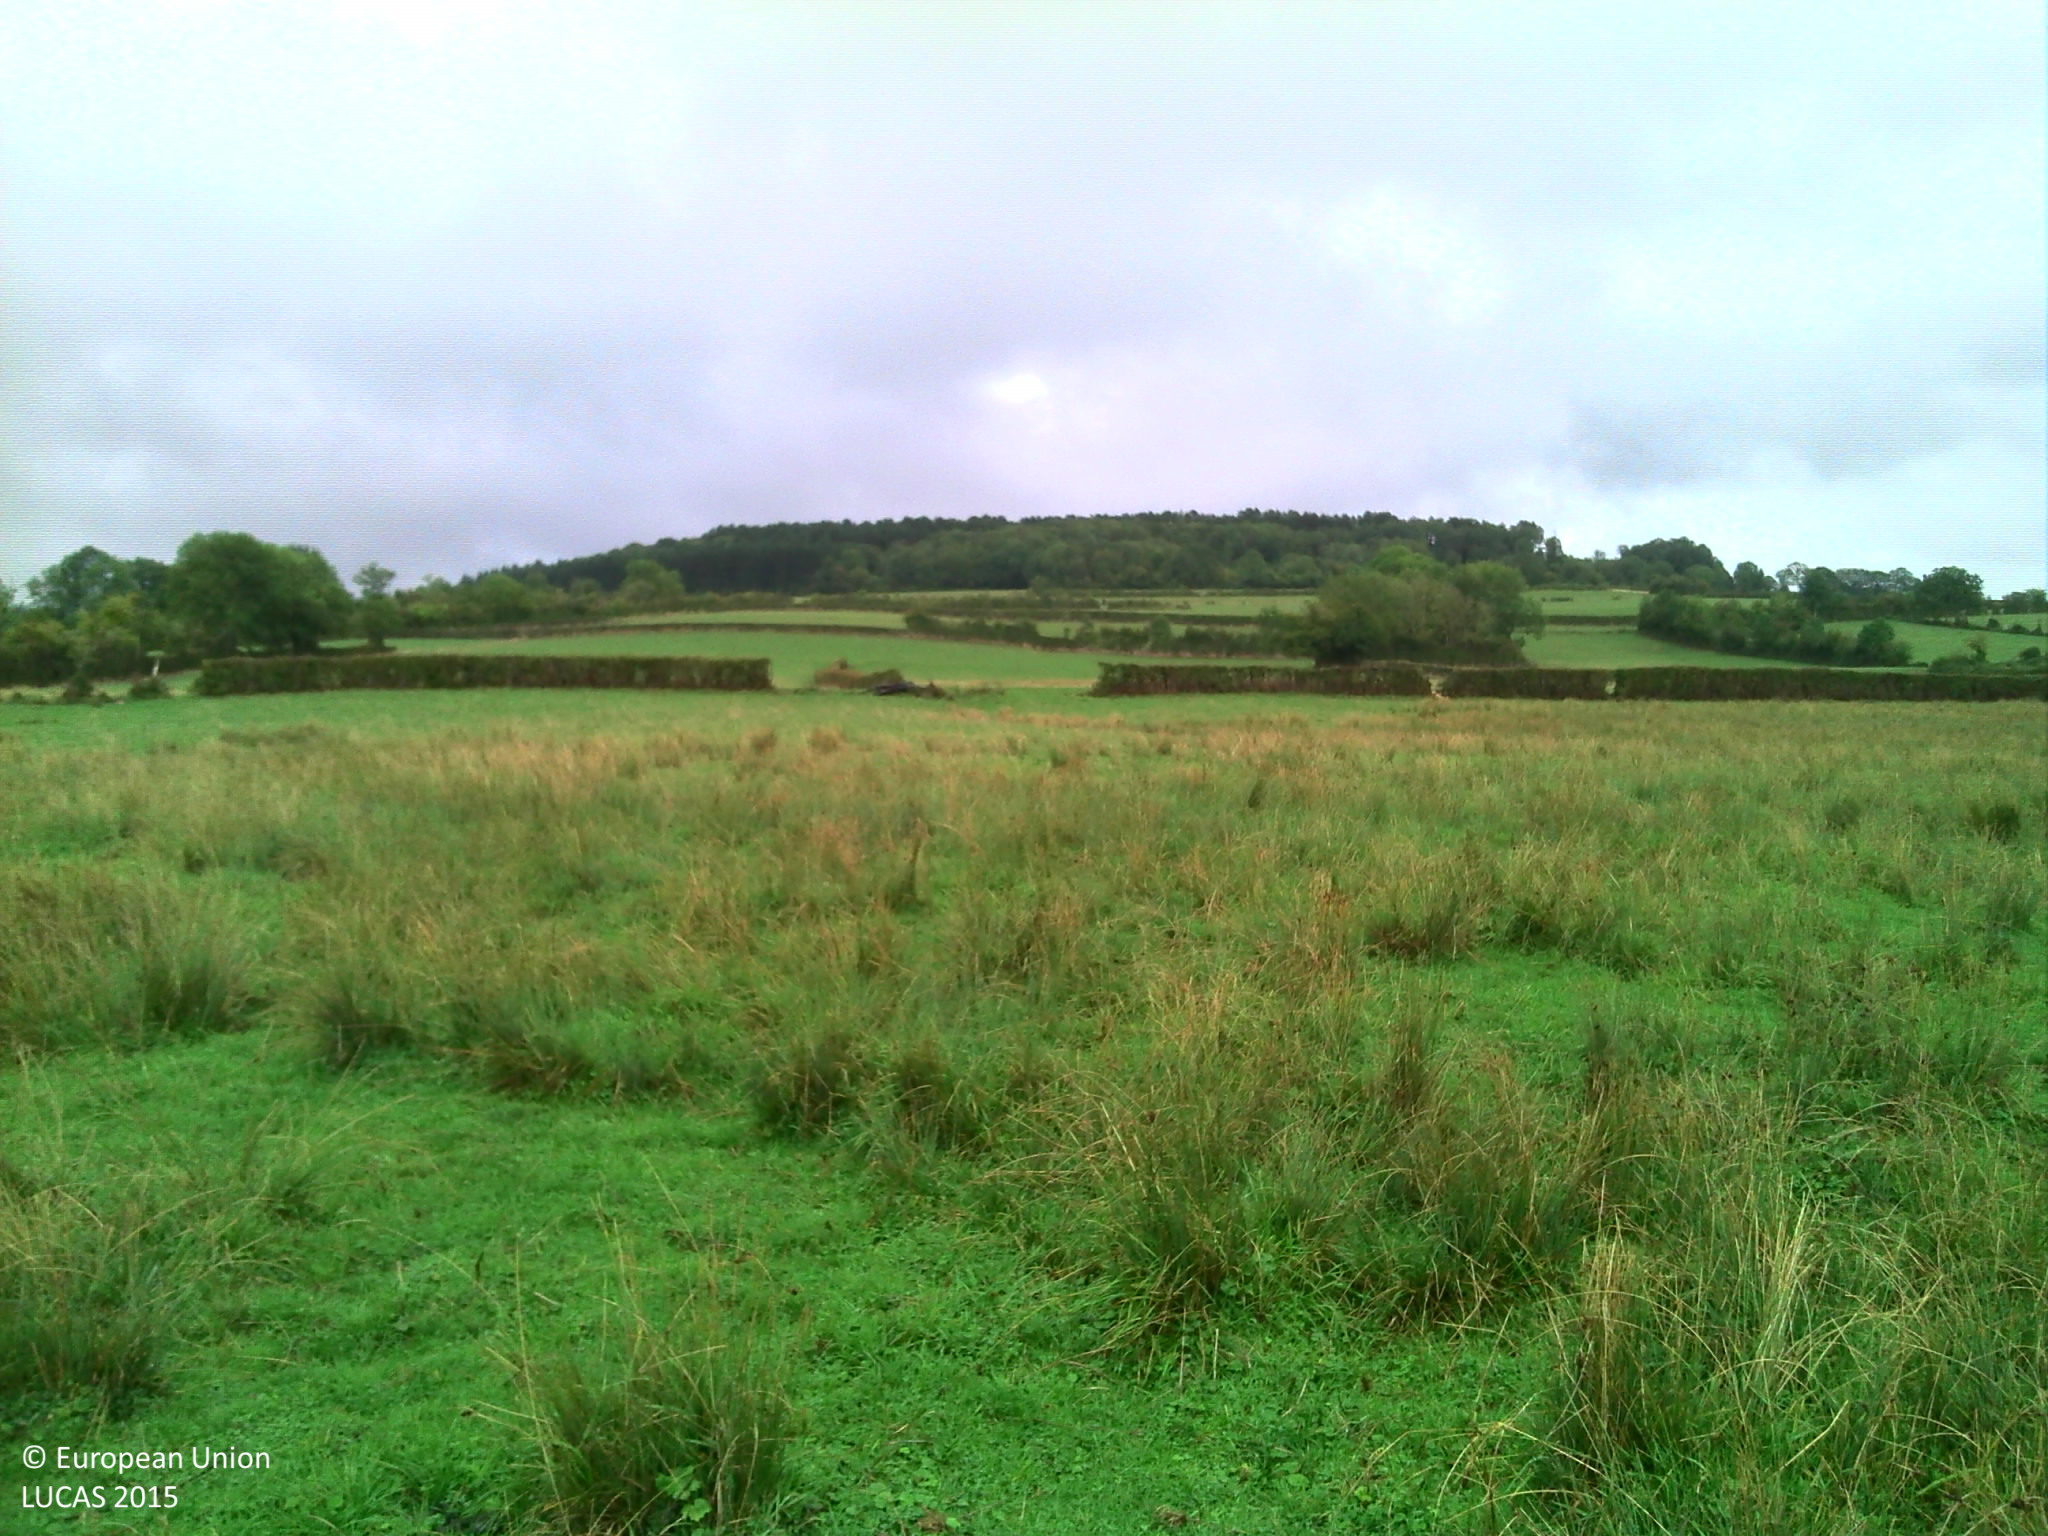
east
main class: Grassland
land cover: Grassland without tree/shrub cover
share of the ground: > 75 %
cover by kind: herbaceous plants 100 %
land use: Agriculture (excluding fallow land and kitchen gardens)
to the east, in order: Grassland without tree/shrub cover; Managed hedges; Grassland without tree/shrub cover
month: September
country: FR
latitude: 47.3043
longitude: 4.3781
